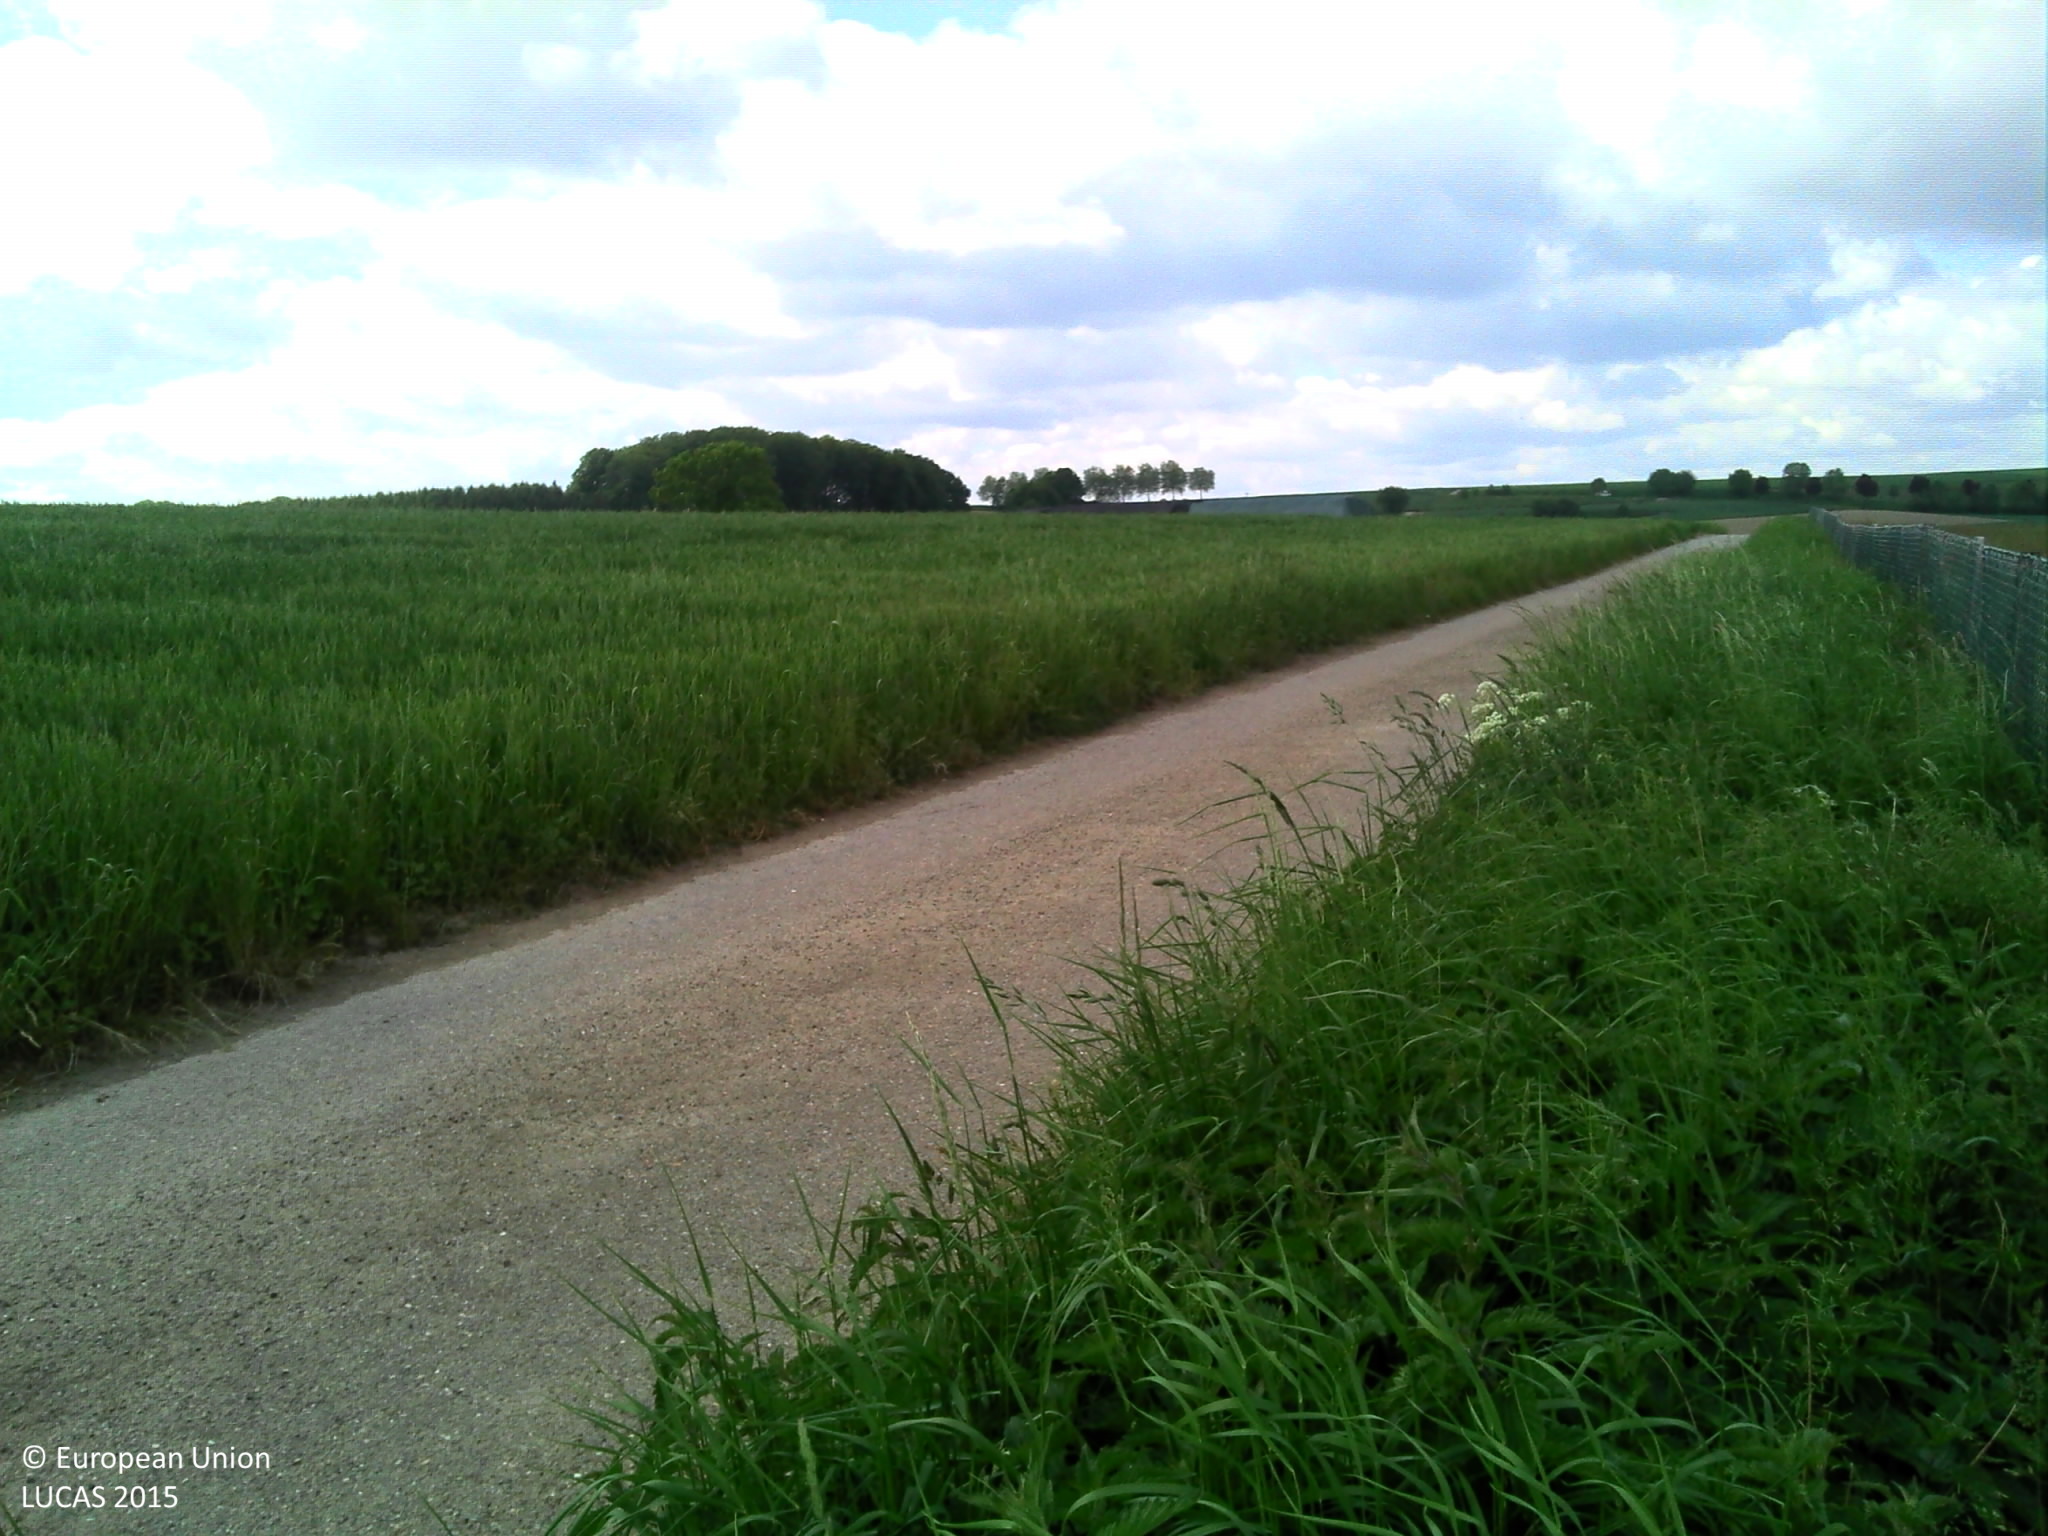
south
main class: Grassland
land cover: Grassland without tree/shrub cover
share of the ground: > 75 %
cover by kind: herbaceous plants 100 %
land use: Agriculture (excluding fallow land and kitchen gardens)
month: May
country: LU
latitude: 49.7289
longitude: 6.3232
